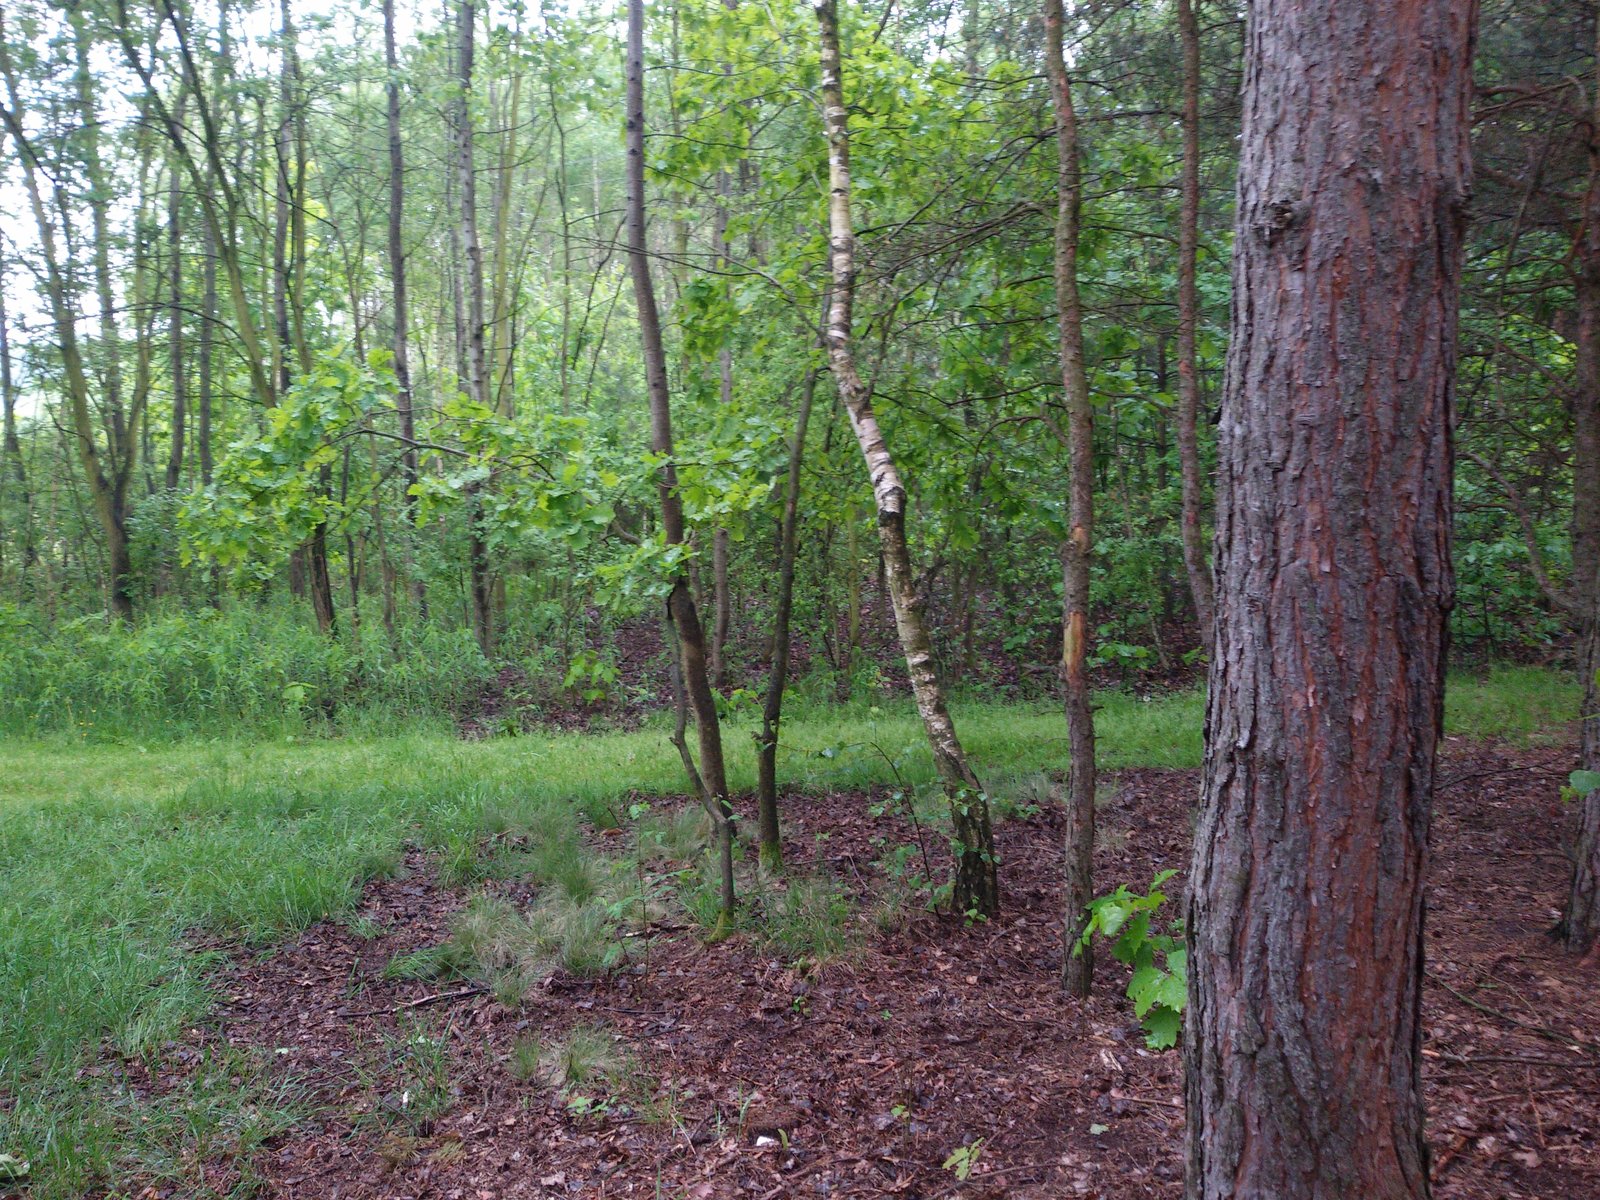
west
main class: Woodland
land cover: Pine dominated mixed woodland
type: hemiboreal forest and nemoral coniferous forest and mixed broadleaved-coniferous forest
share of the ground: > 75 %
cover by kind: coniferous forest trees 60 %, broadleaved forest trees 25 %, herbaceous plants 10 %, unconsolidated bare surface 5 %
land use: Forestry
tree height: > 5 m
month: May
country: PL
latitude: 50.1458
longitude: 21.3127
